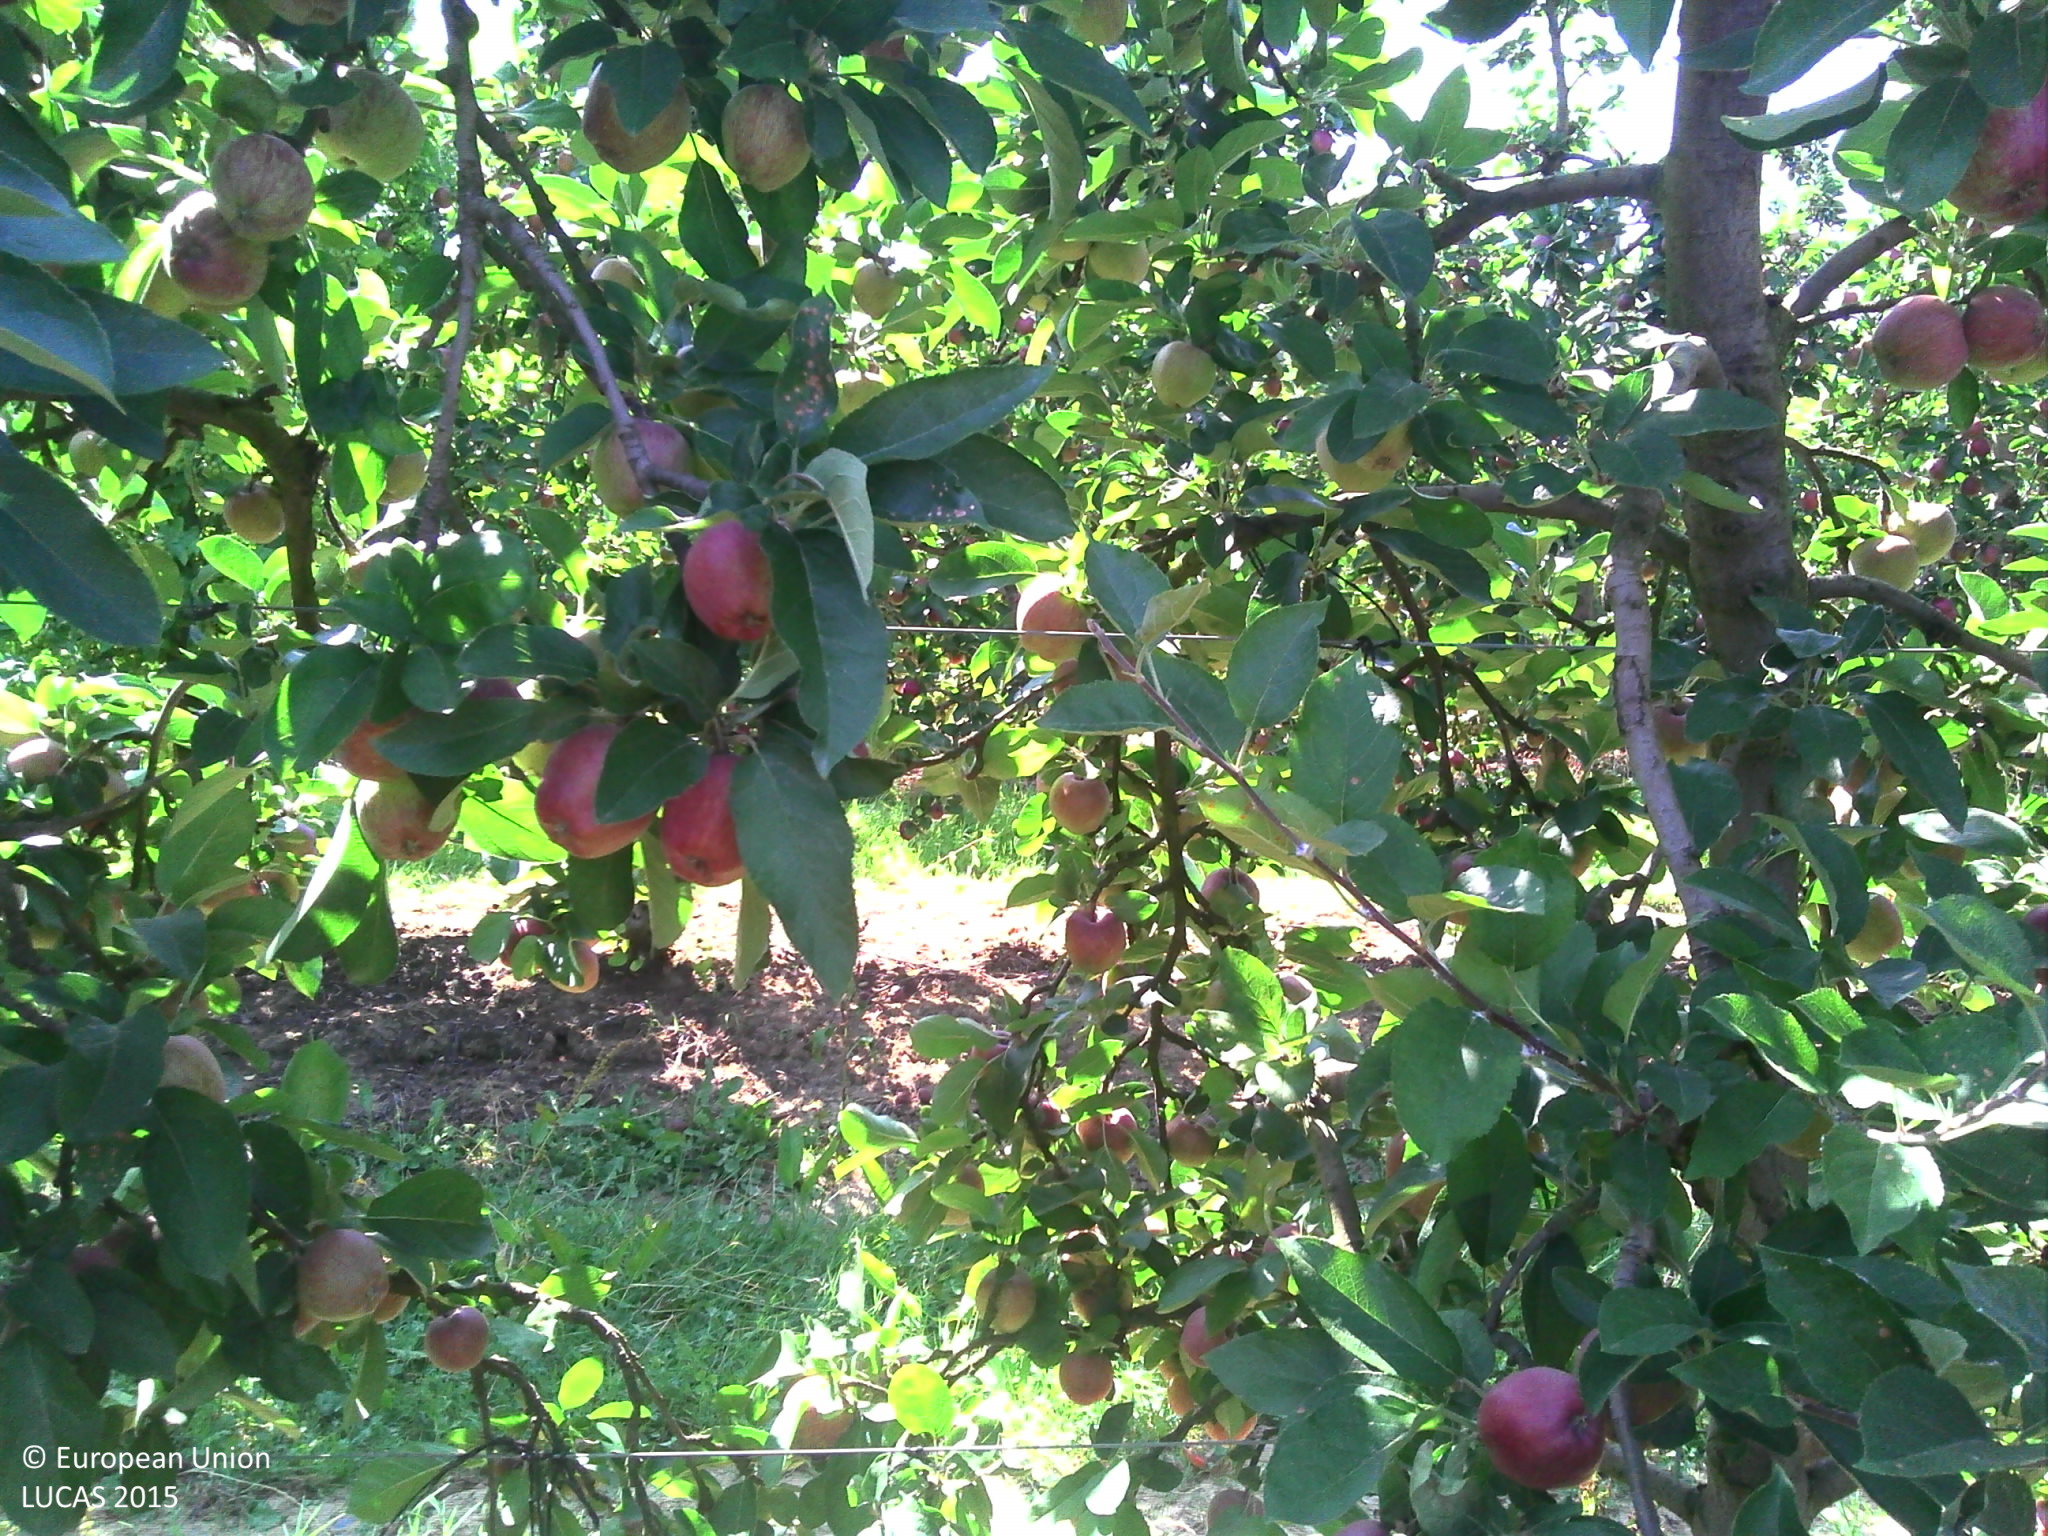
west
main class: Cropland
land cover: Apple fruit
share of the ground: 25 - 50 %
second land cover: Grassland without tree/shrub cover
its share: 25 - 50 %
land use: Agriculture (excluding fallow land and kitchen gardens)
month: July
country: FR
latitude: 44.0472
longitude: 0.9741
